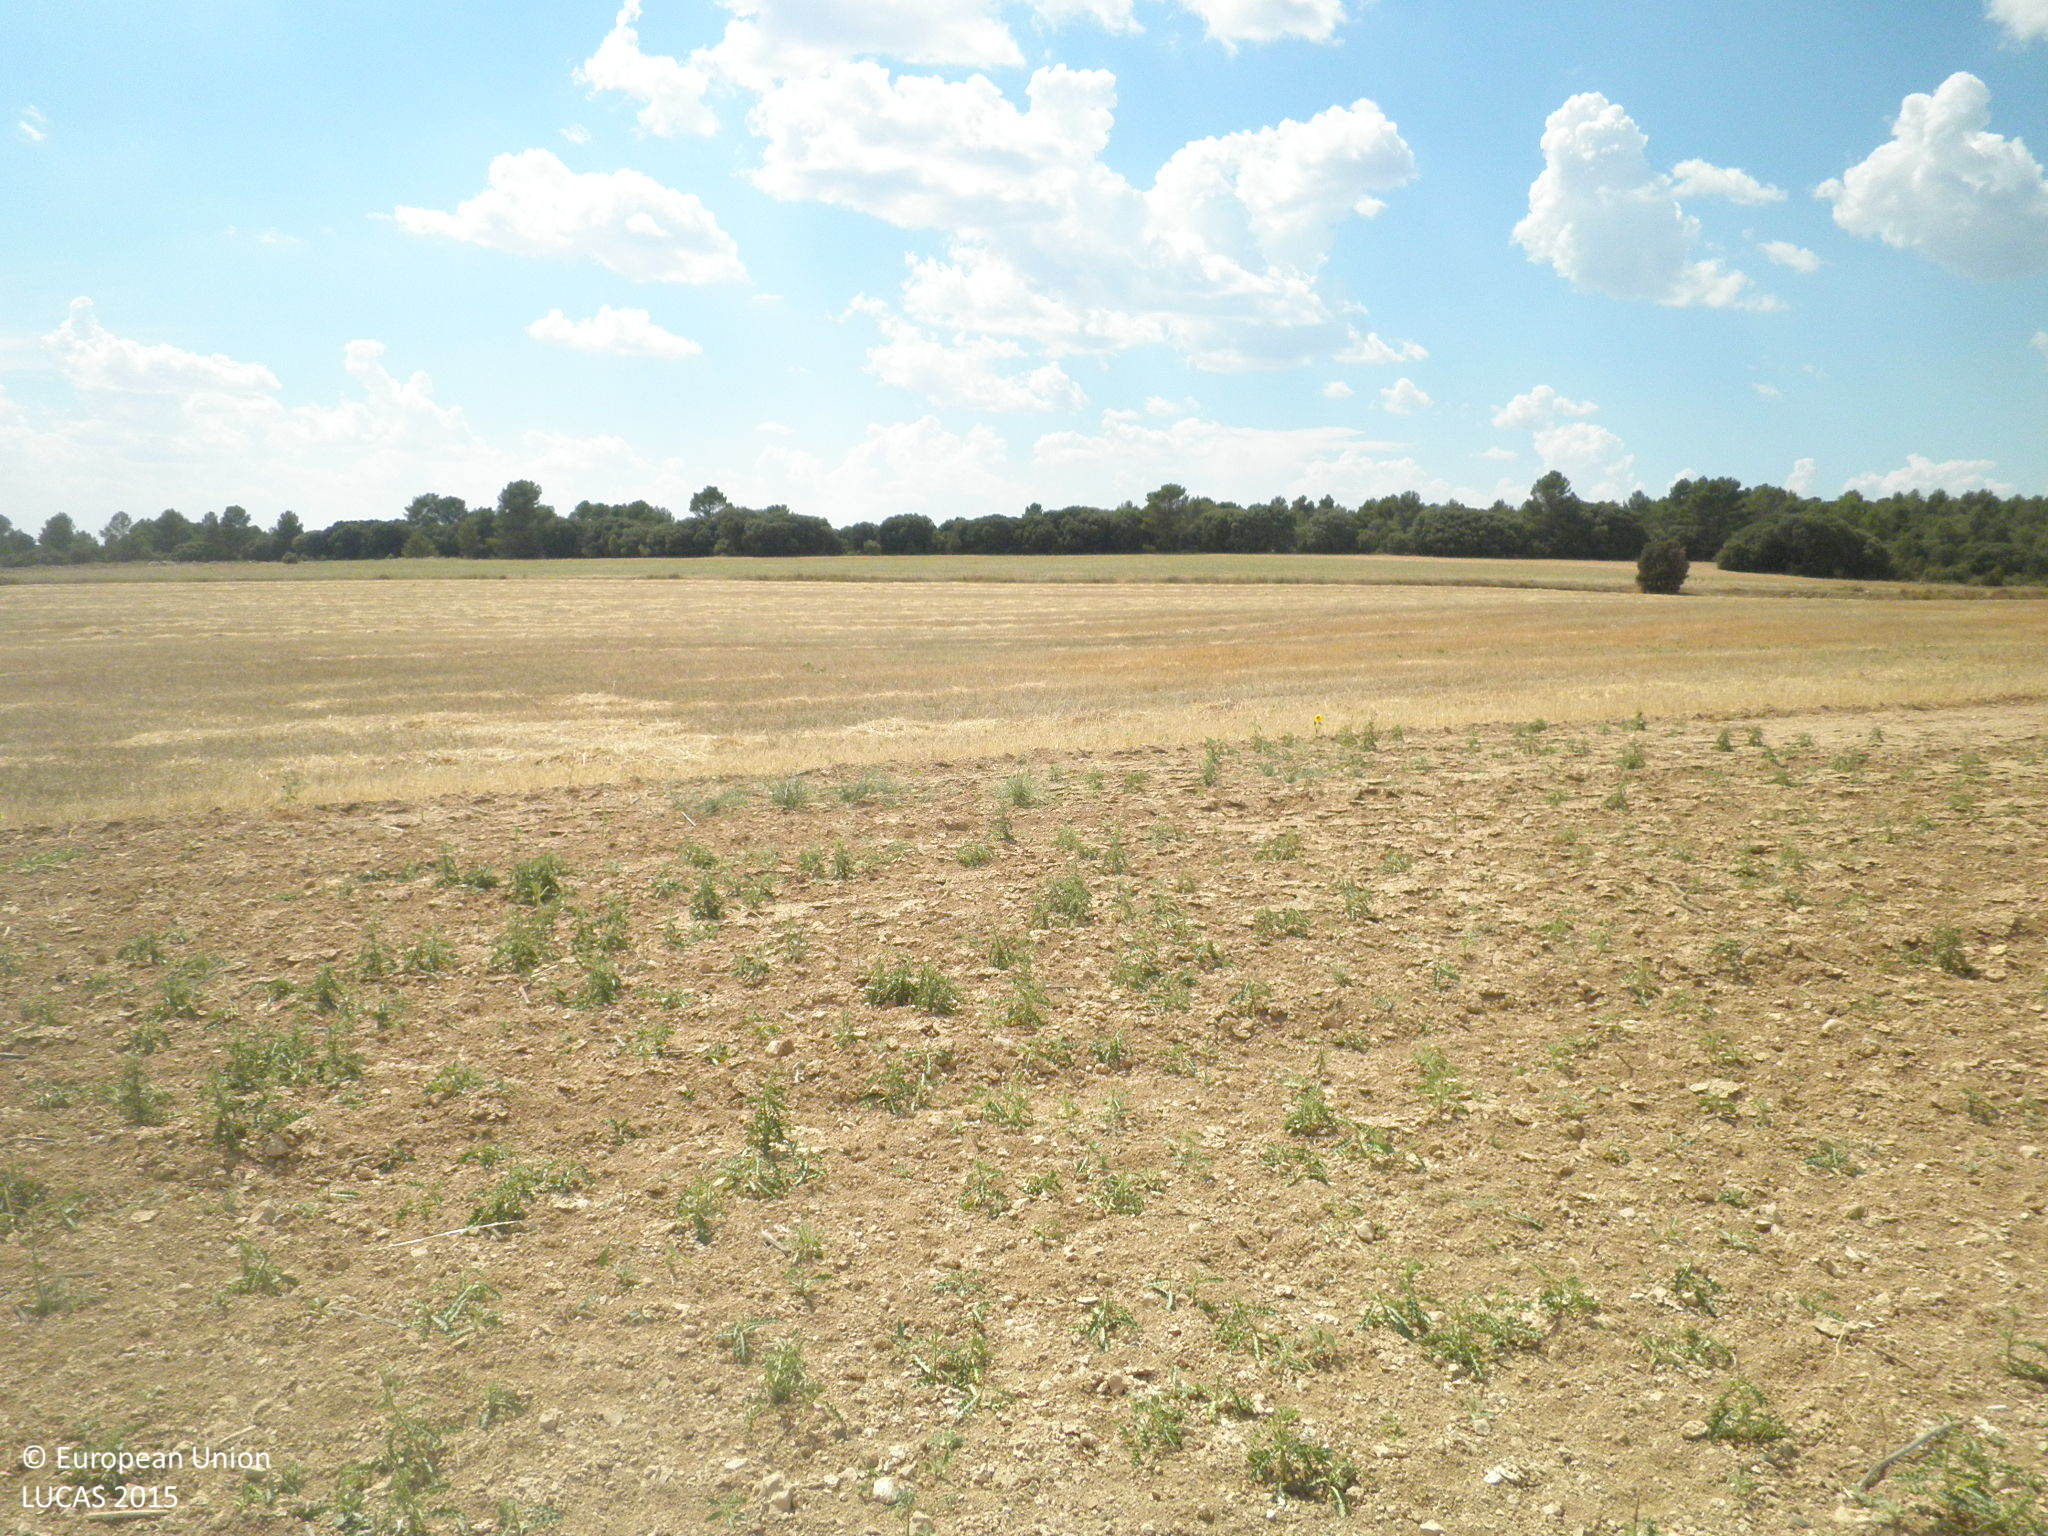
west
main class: Grassland
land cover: Spontaneously vegetated surfaces
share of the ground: 10 - 25 %
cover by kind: unconsolidated bare surface 90 %, herbaceous plants 10 %
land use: Fallow land
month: July
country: ES
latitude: 39.6413
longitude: -1.6711
